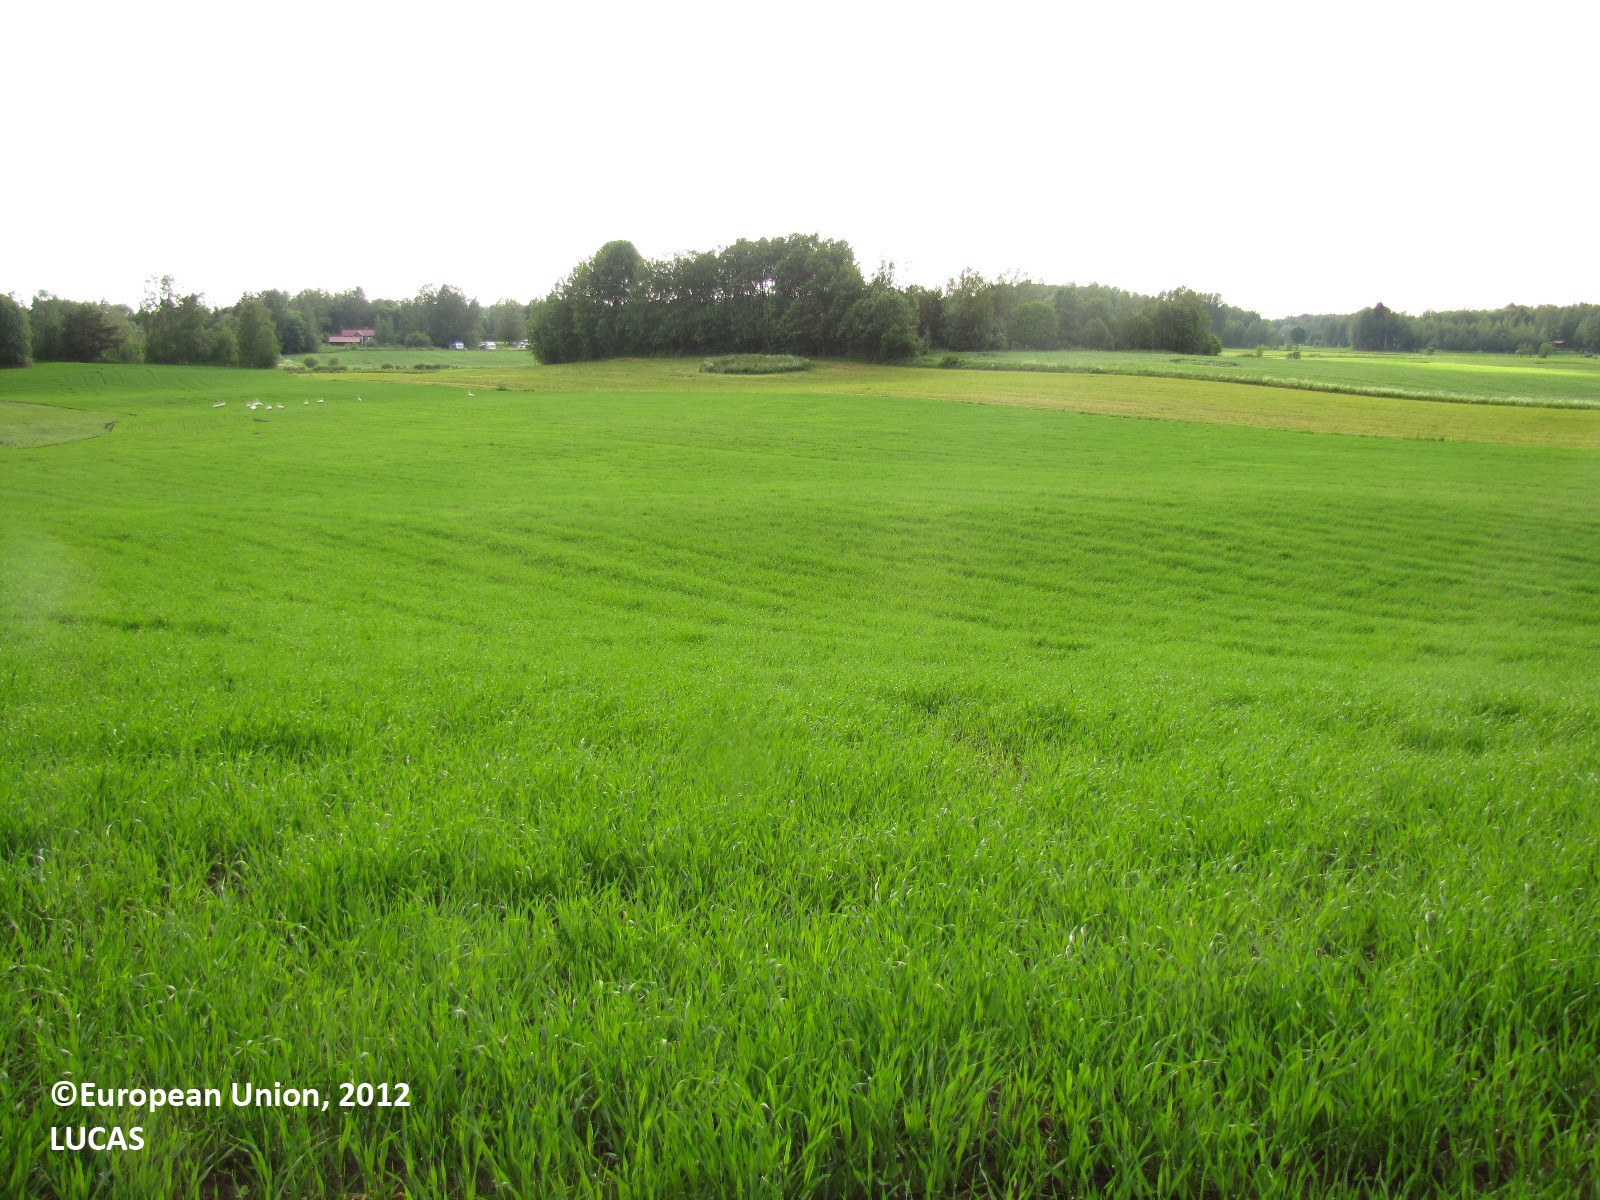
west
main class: Cropland
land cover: Barley
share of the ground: 50 - 75 %
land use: Agriculture (excluding fallow land and kitchen gardens)
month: June
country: FI
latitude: 61.2356
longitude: 24.5770
